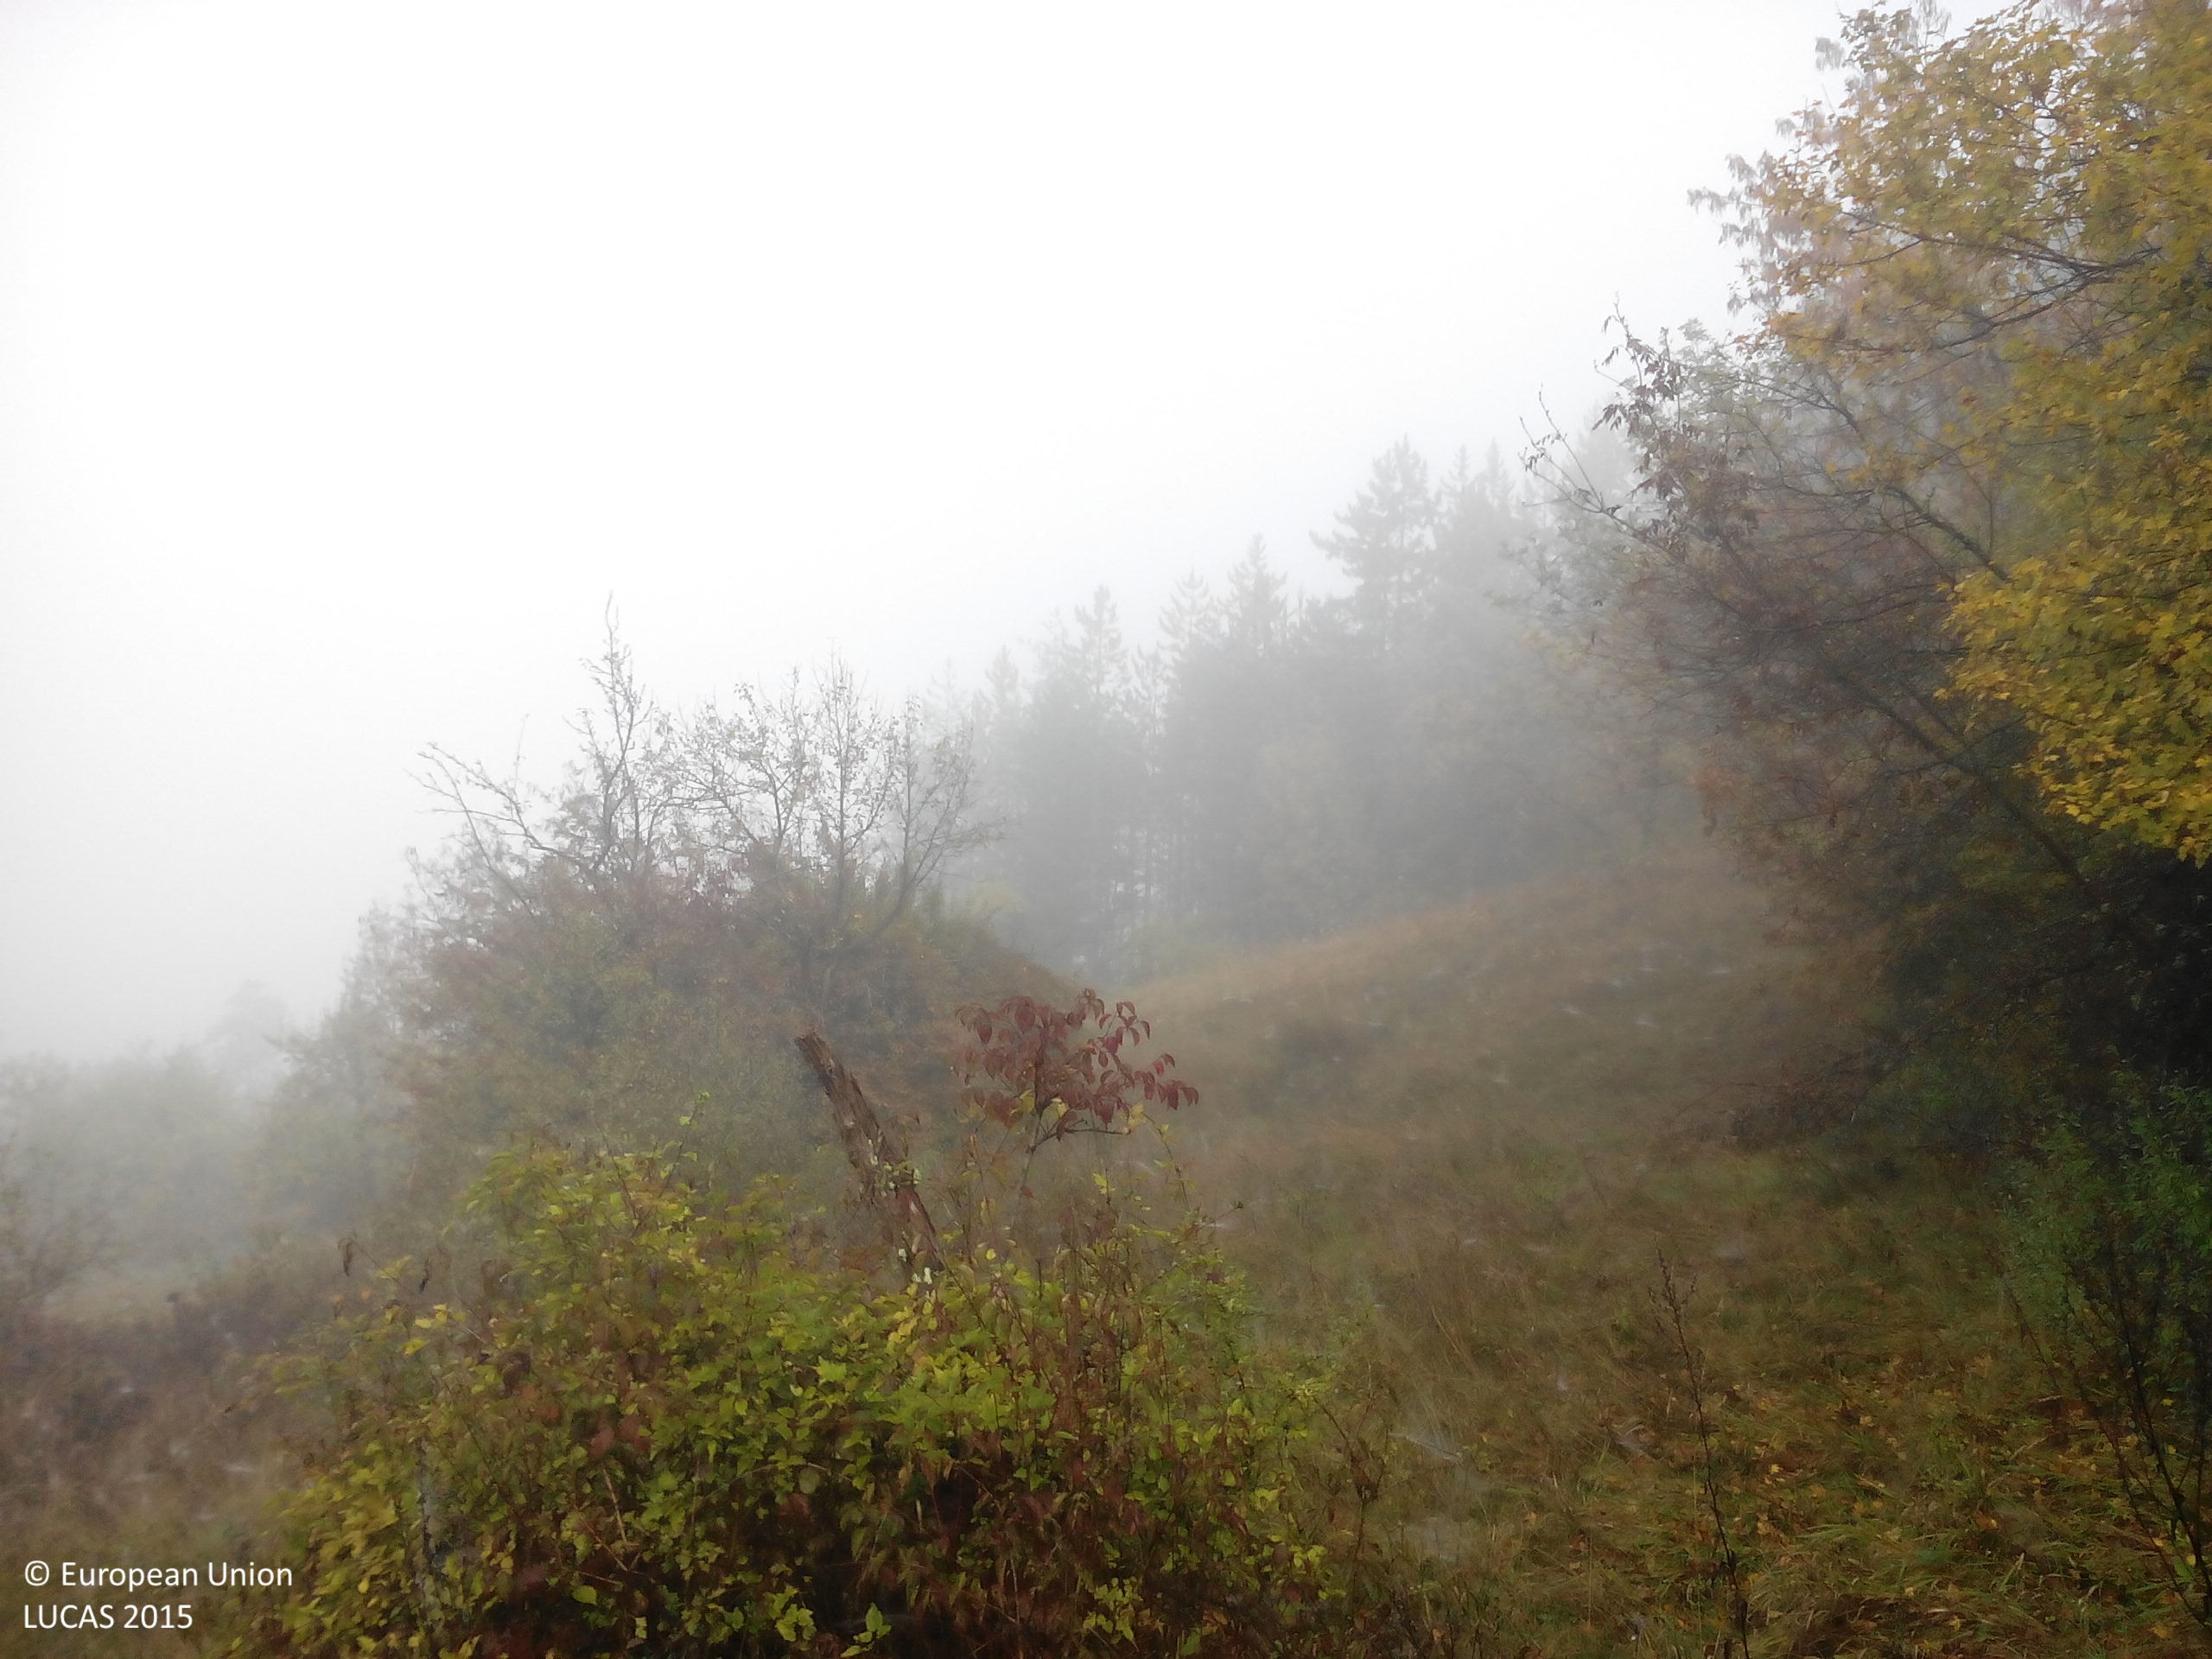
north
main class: Woodland
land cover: Broadleaved woodland
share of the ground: 50 - 75 %
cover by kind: shrubs 50 %, herbaceous plants 30 %, broadleaved forest trees 20 %
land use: Abandoned areas
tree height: > 5 m
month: October
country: BG
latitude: 42.9634
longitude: 24.0860
